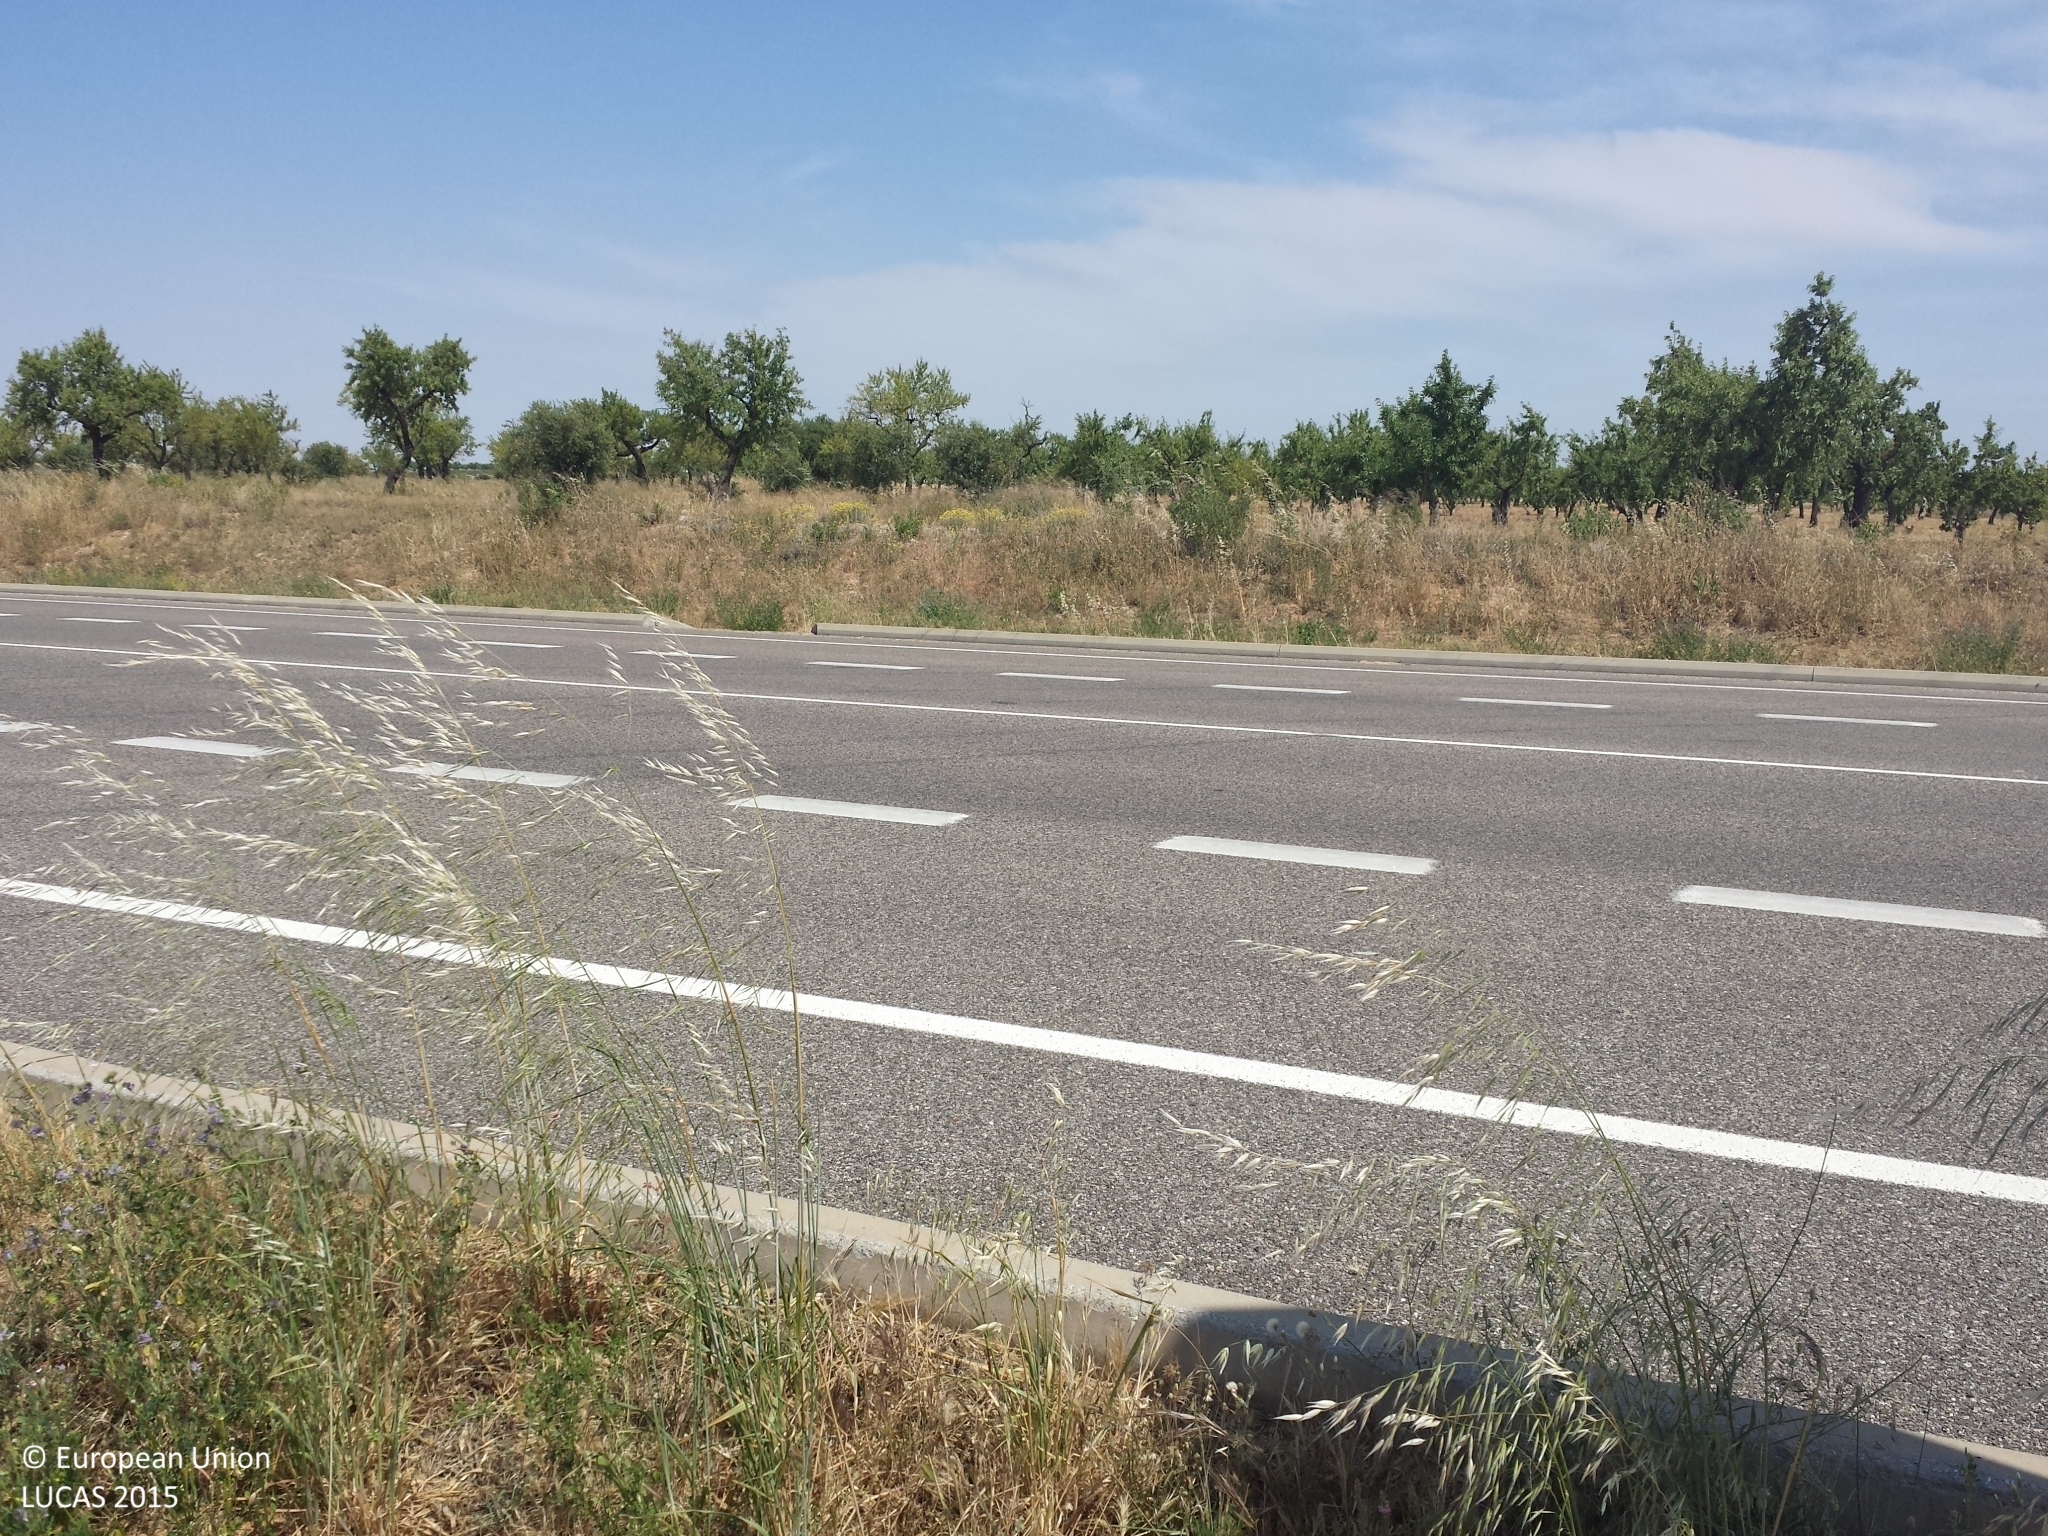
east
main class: Grassland
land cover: Grassland without tree/shrub cover
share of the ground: 50 - 75 %
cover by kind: herbaceous plants 60 %, unconsolidated bare surface 30 %, shrubs 5 %, consolidated bare surface 5 %
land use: Road transport
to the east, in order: Grassland without tree/shrub cover; Electric lines; Grassland without tree/shrub cover; Paved roads, cycling and walking lanes; Grass margins; Tracks; Nuts trees; Shruby margins; Nuts trees; Shrubland with sparse tree cover; Dry stone walls; Tracks; Olive groves; Dry stone walls; Olive groves
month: May
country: ES
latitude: 41.4899
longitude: 0.6101
